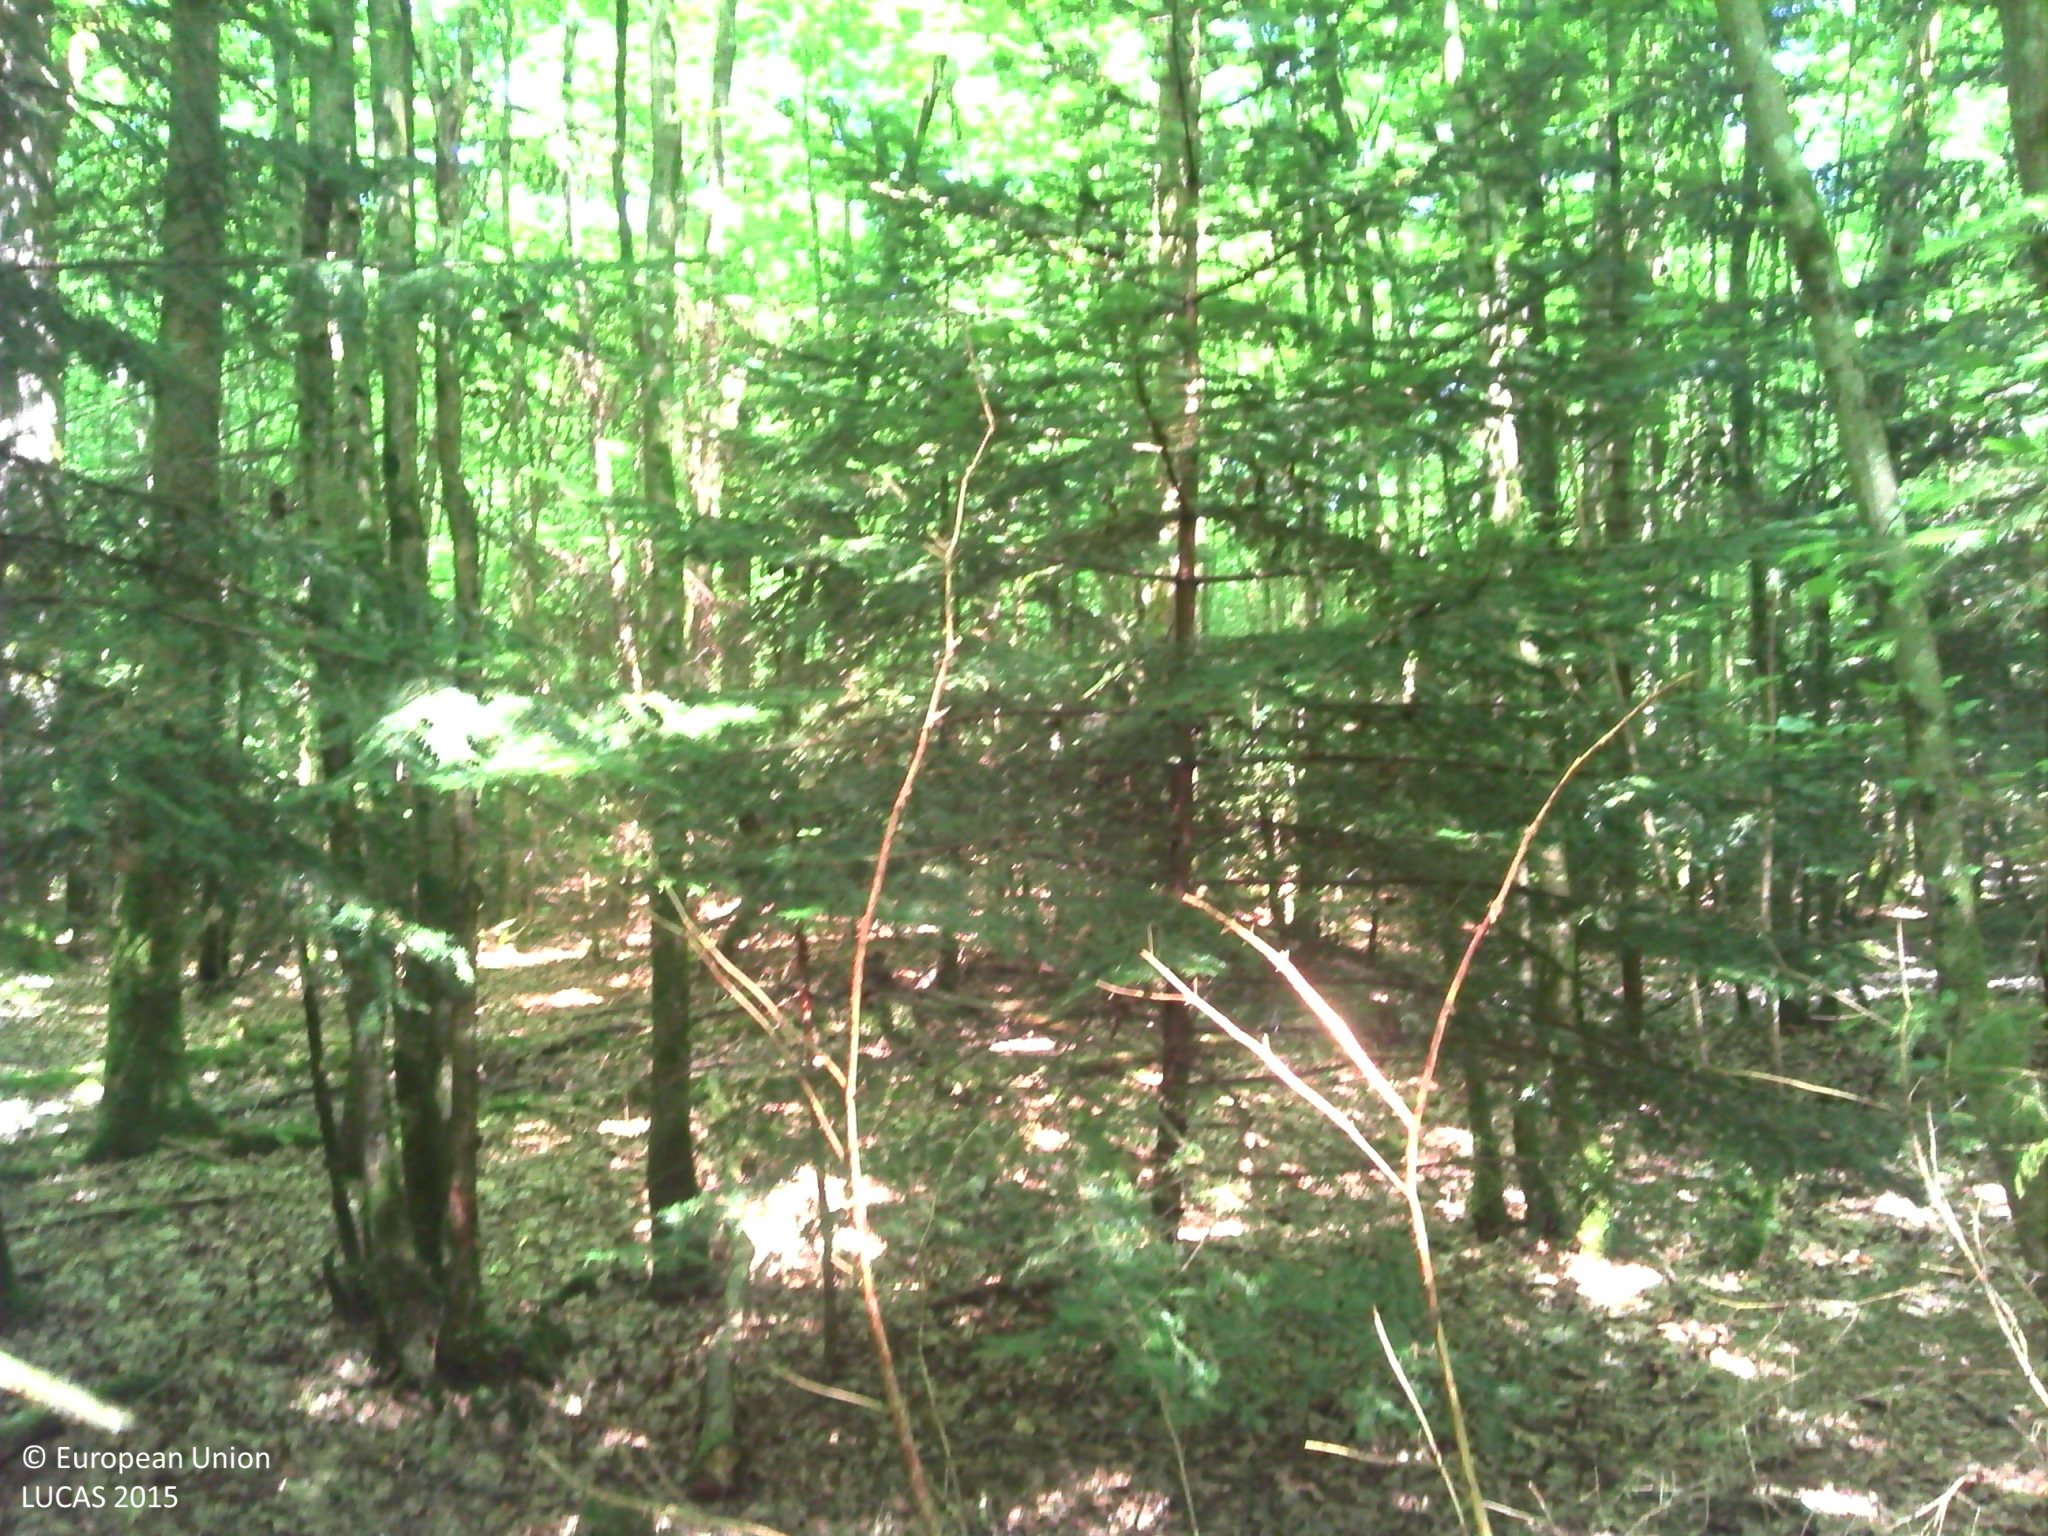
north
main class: Woodland
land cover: Spruce dominated mixed woodland
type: mesophytic deciduous forest
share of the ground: > 75 %
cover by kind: broadleaved forest trees 50 %, coniferous forest trees 45 %, herbaceous plants 5 %
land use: Forestry
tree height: > 5 m
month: June
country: FR
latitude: 48.4673
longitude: 4.9264
